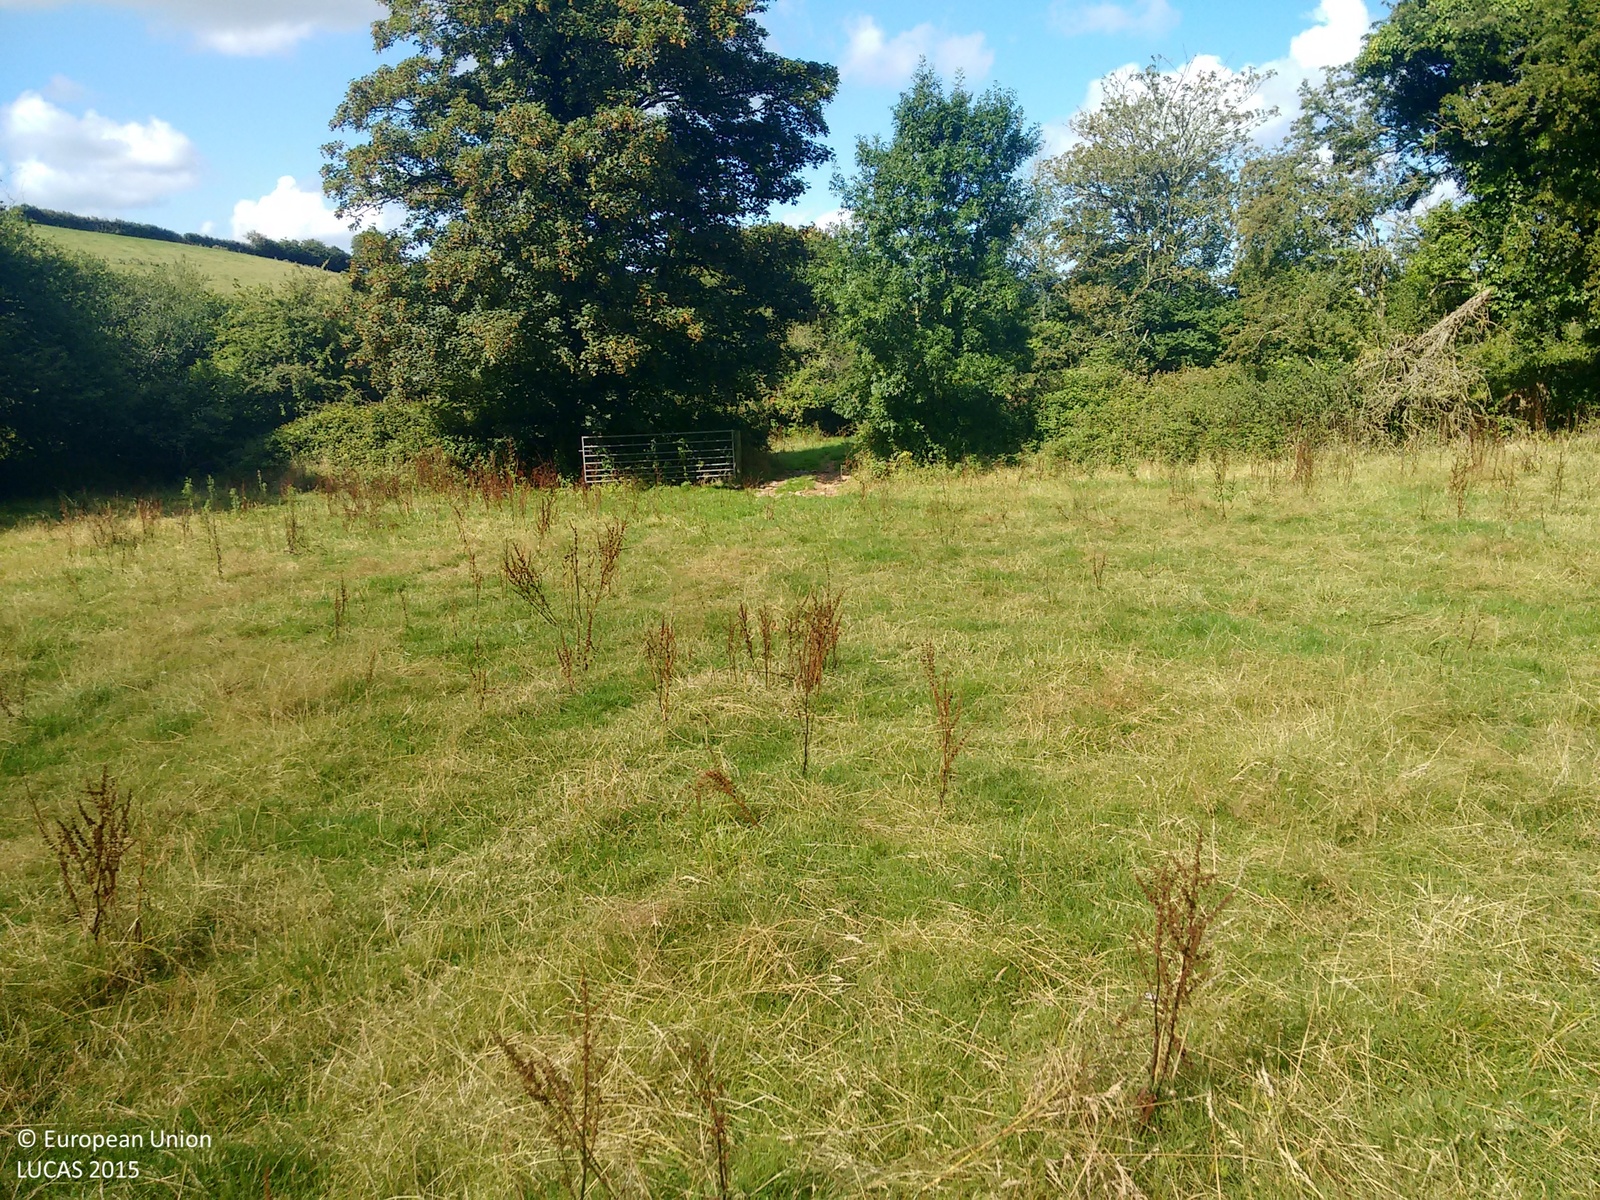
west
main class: Grassland
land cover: Grassland without tree/shrub cover
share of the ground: > 75 %
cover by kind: herbaceous plants 100 %
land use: Agriculture (excluding fallow land and kitchen gardens)
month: August
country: GB
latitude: 50.2961
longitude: -4.8949
